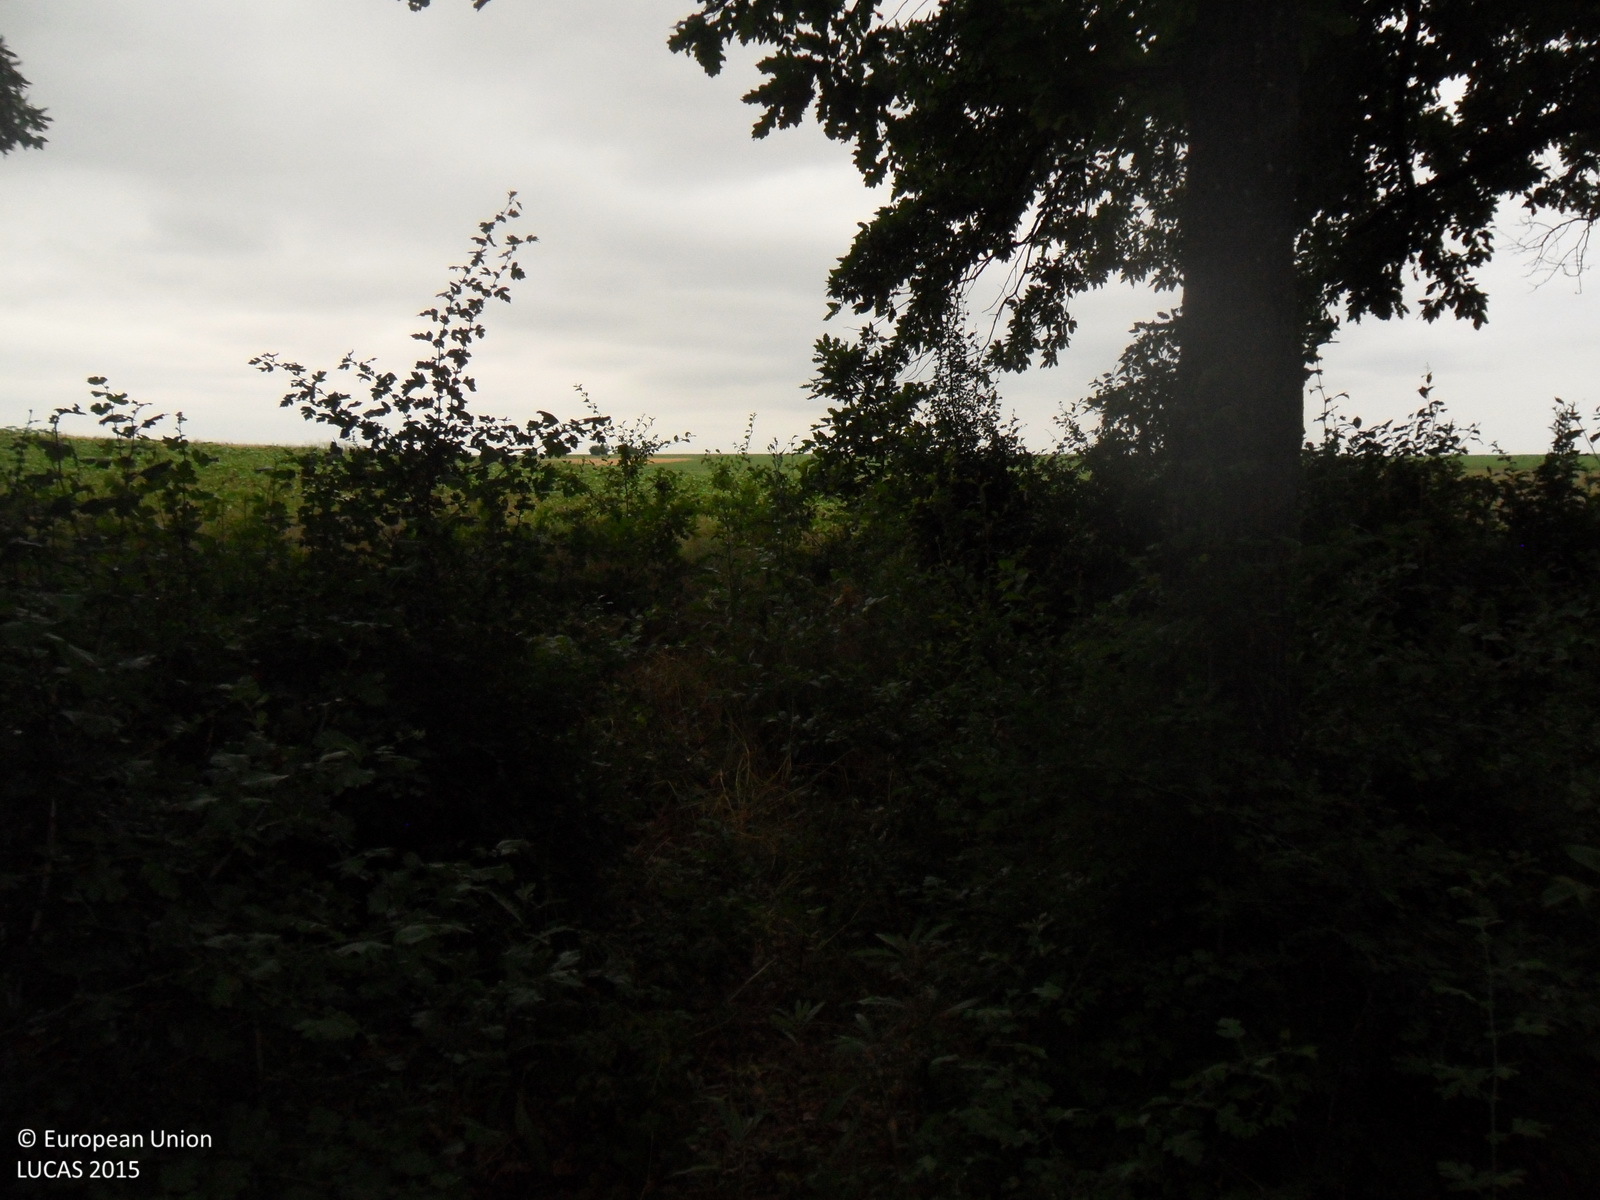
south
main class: Woodland
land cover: Broadleaved woodland
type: thermophilous deciduous forest
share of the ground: > 75 %
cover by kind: broadleaved forest trees 100 %
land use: Forestry
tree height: > 5 m
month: June
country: BG
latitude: 43.7724
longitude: 26.7236
